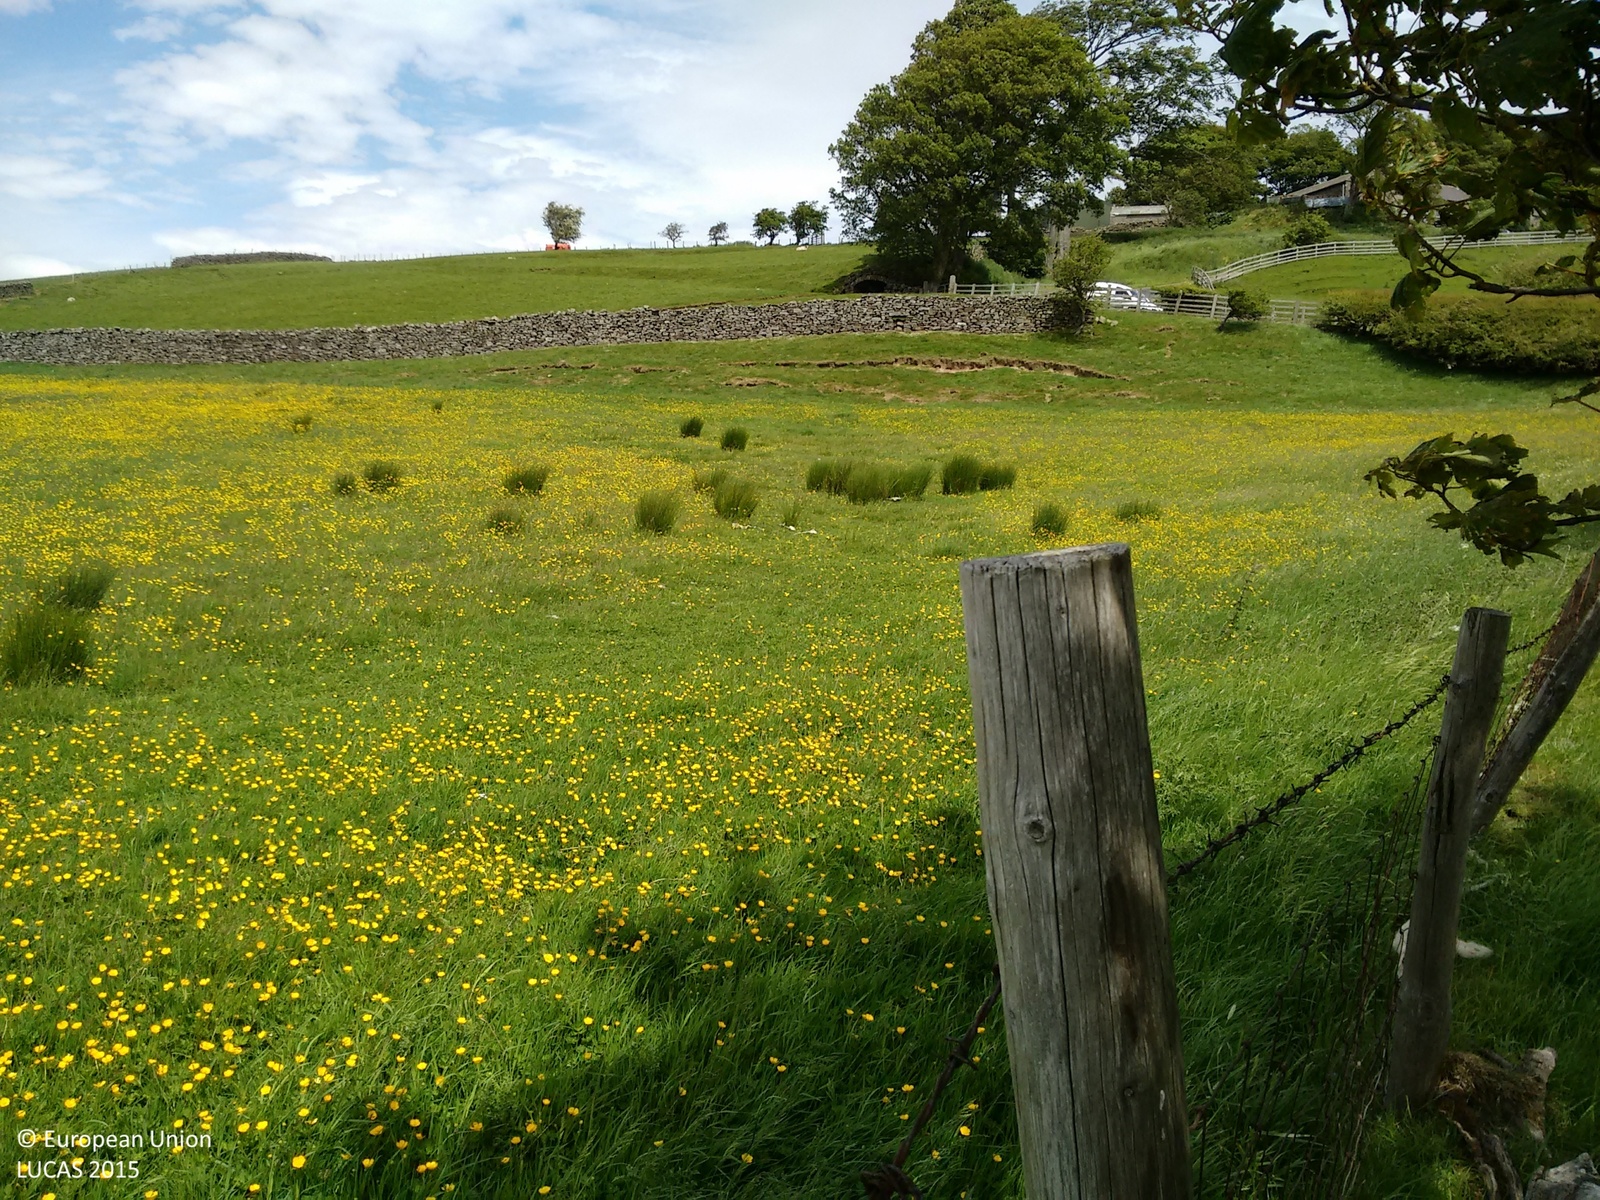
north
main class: Grassland
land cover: Grassland without tree/shrub cover
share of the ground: > 75 %
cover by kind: herbaceous plants 100 %
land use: Agriculture (excluding fallow land and kitchen gardens)
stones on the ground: < 10 %
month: June
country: GB
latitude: 54.1619
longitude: -1.8623
